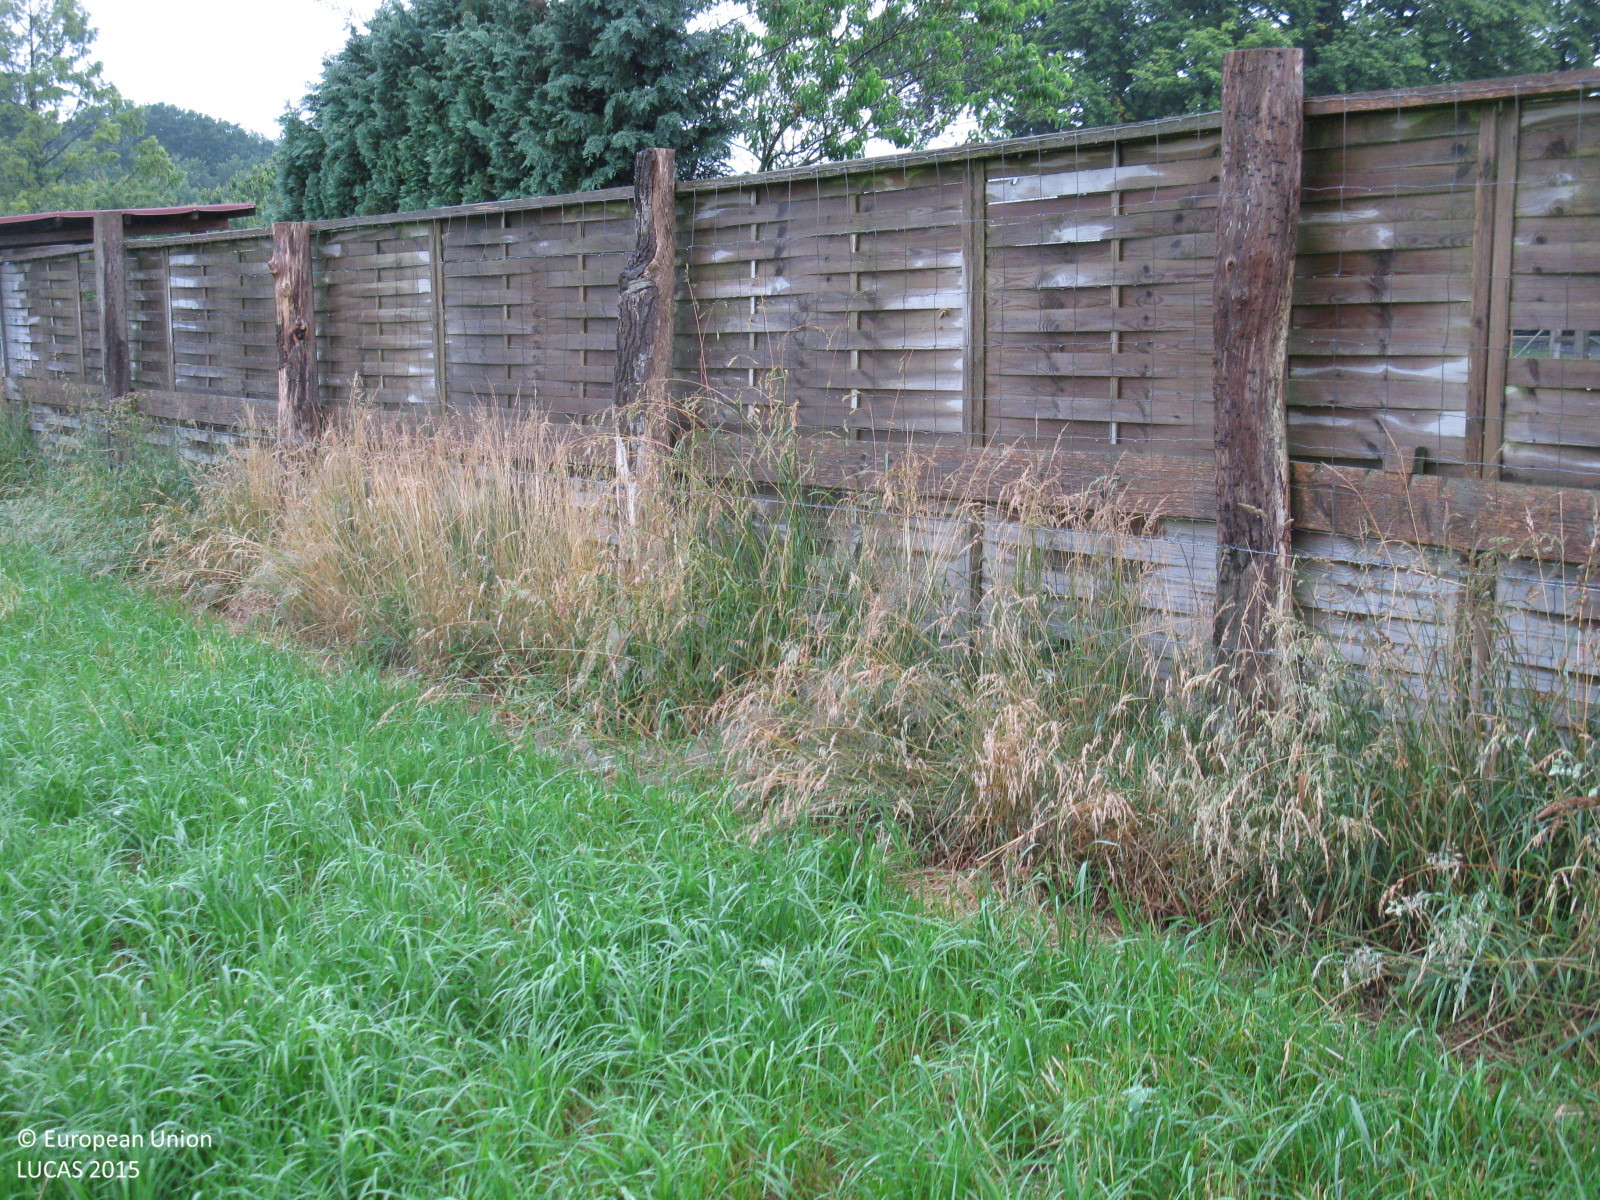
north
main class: Grassland
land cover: Grassland without tree/shrub cover
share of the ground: > 75 %
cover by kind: herbaceous plants 100 %
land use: Agriculture (excluding fallow land and kitchen gardens)
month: July
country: DE
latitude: 53.2772
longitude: 7.9761
